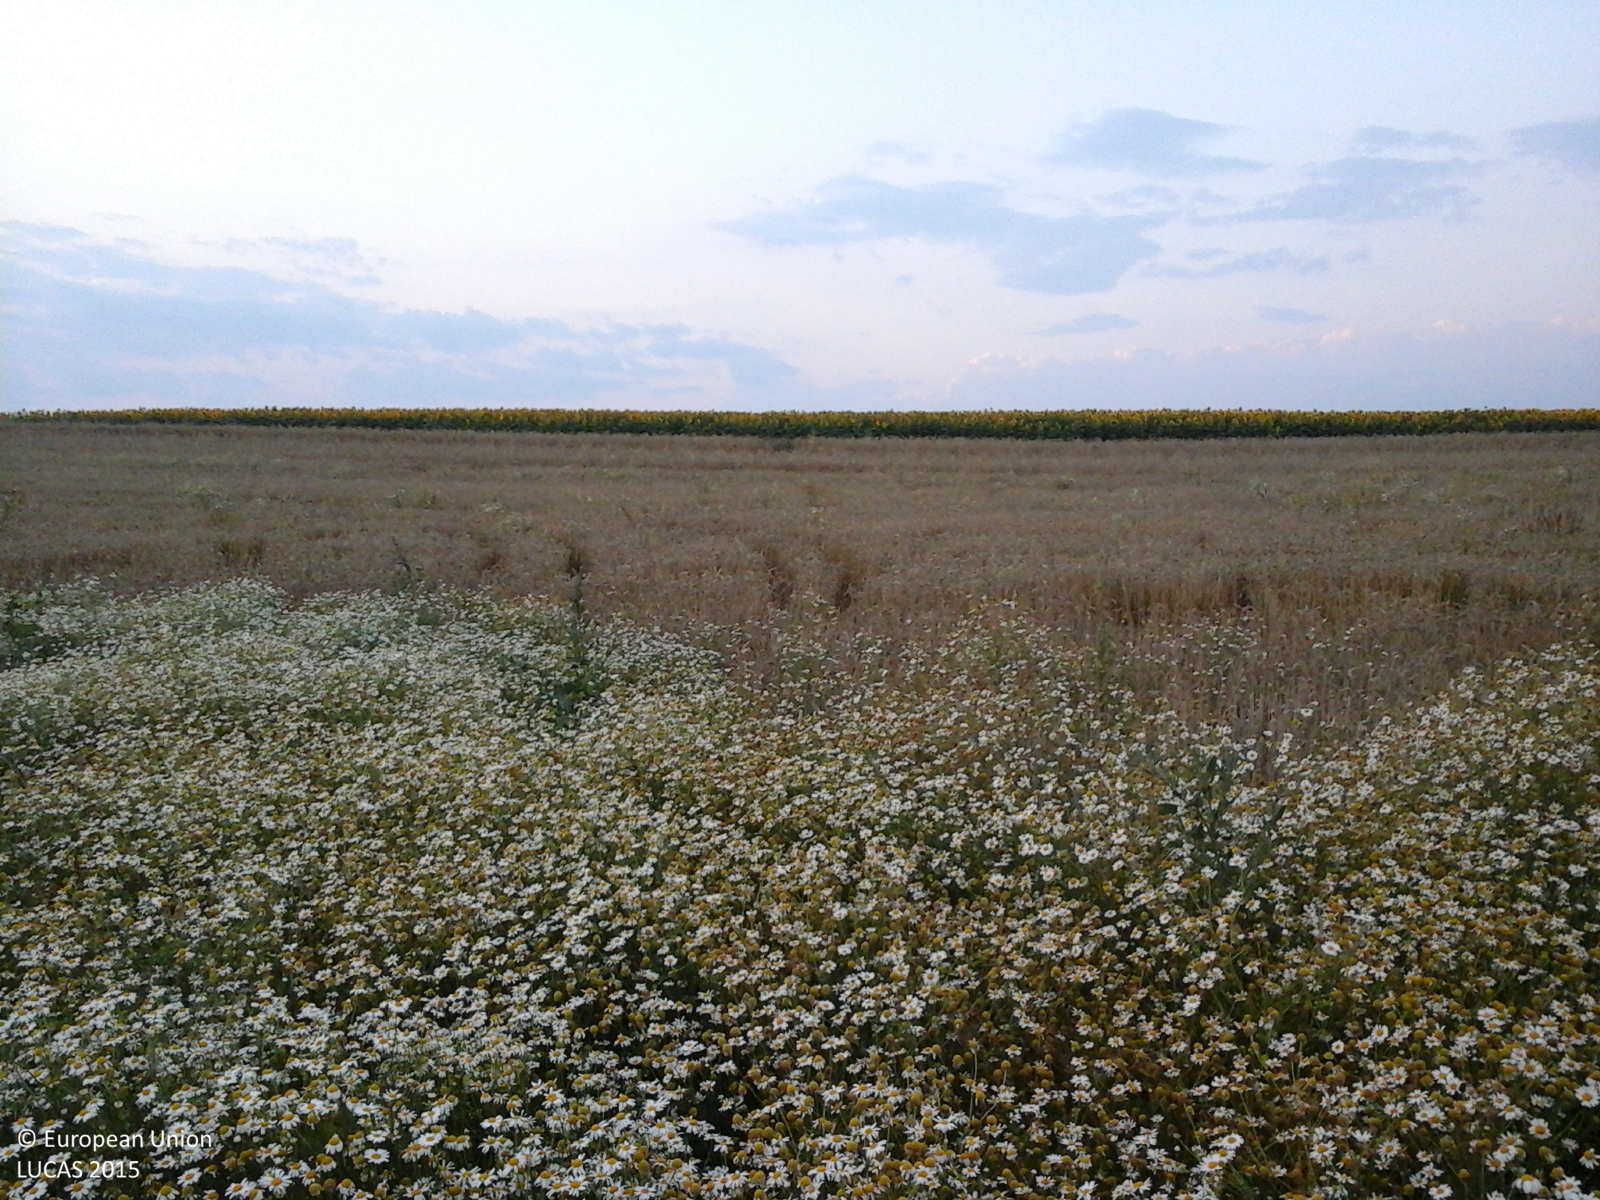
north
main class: Cropland
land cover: Other non-permanent industrial crops
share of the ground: > 75 %
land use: Agriculture (excluding fallow land and kitchen gardens)
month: July
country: RO
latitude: 43.7799
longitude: 25.2756
